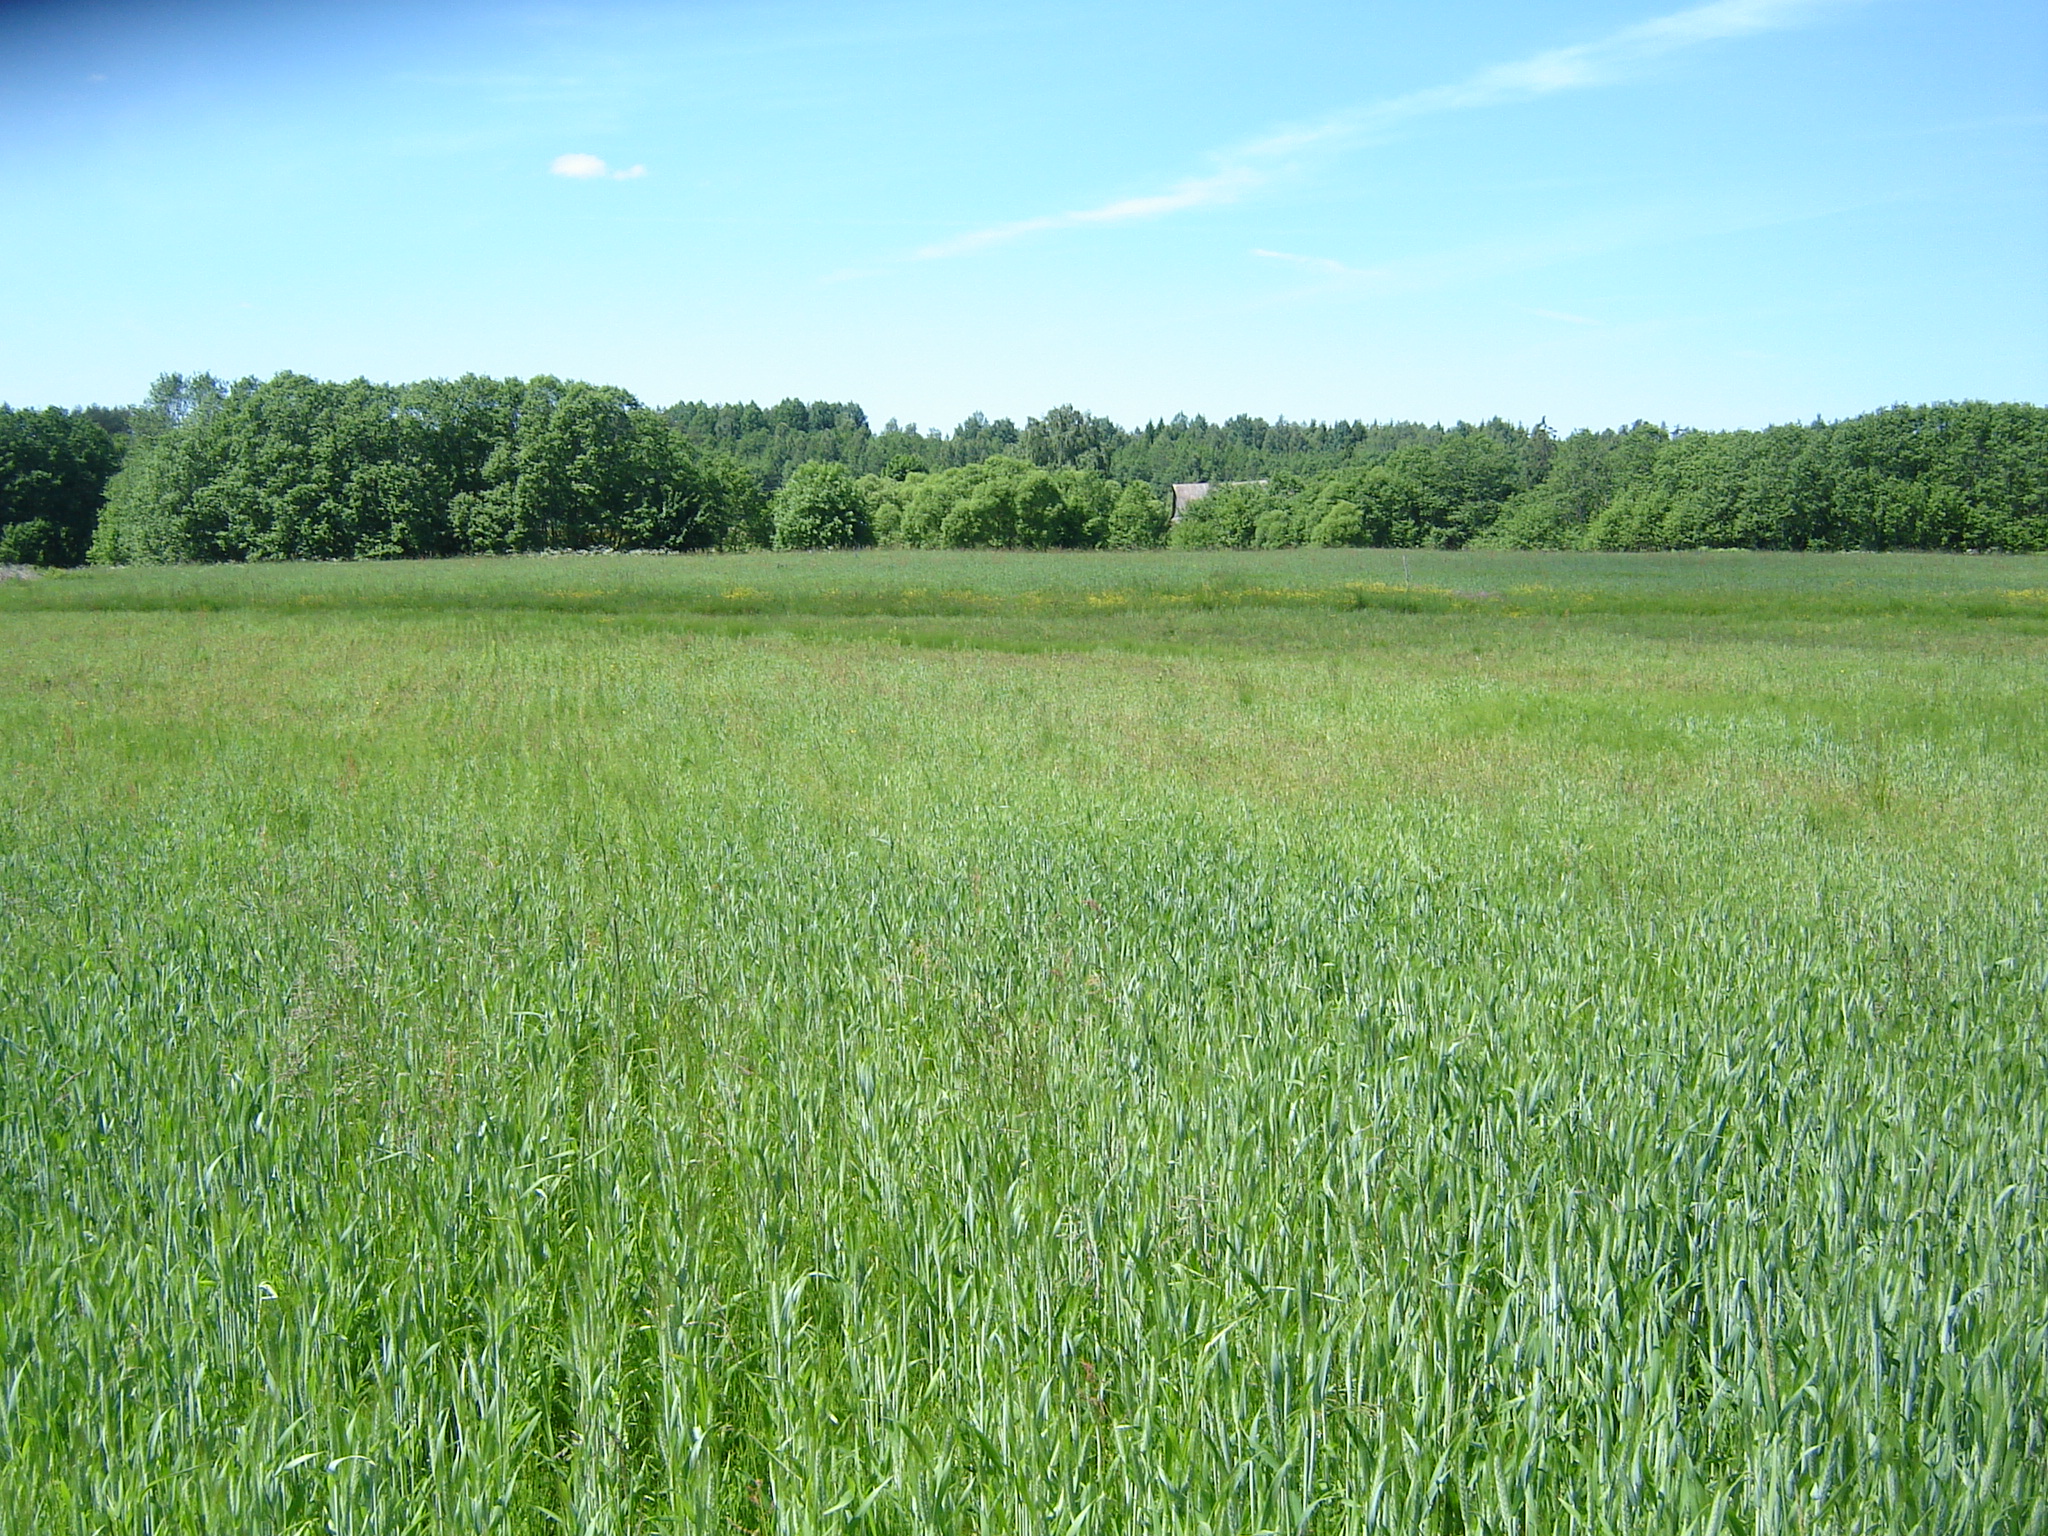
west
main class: Cropland
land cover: Rye
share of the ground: > 75 %
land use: Agriculture (excluding fallow land and kitchen gardens)
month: June
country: LT
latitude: 55.6745
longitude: 25.0760
